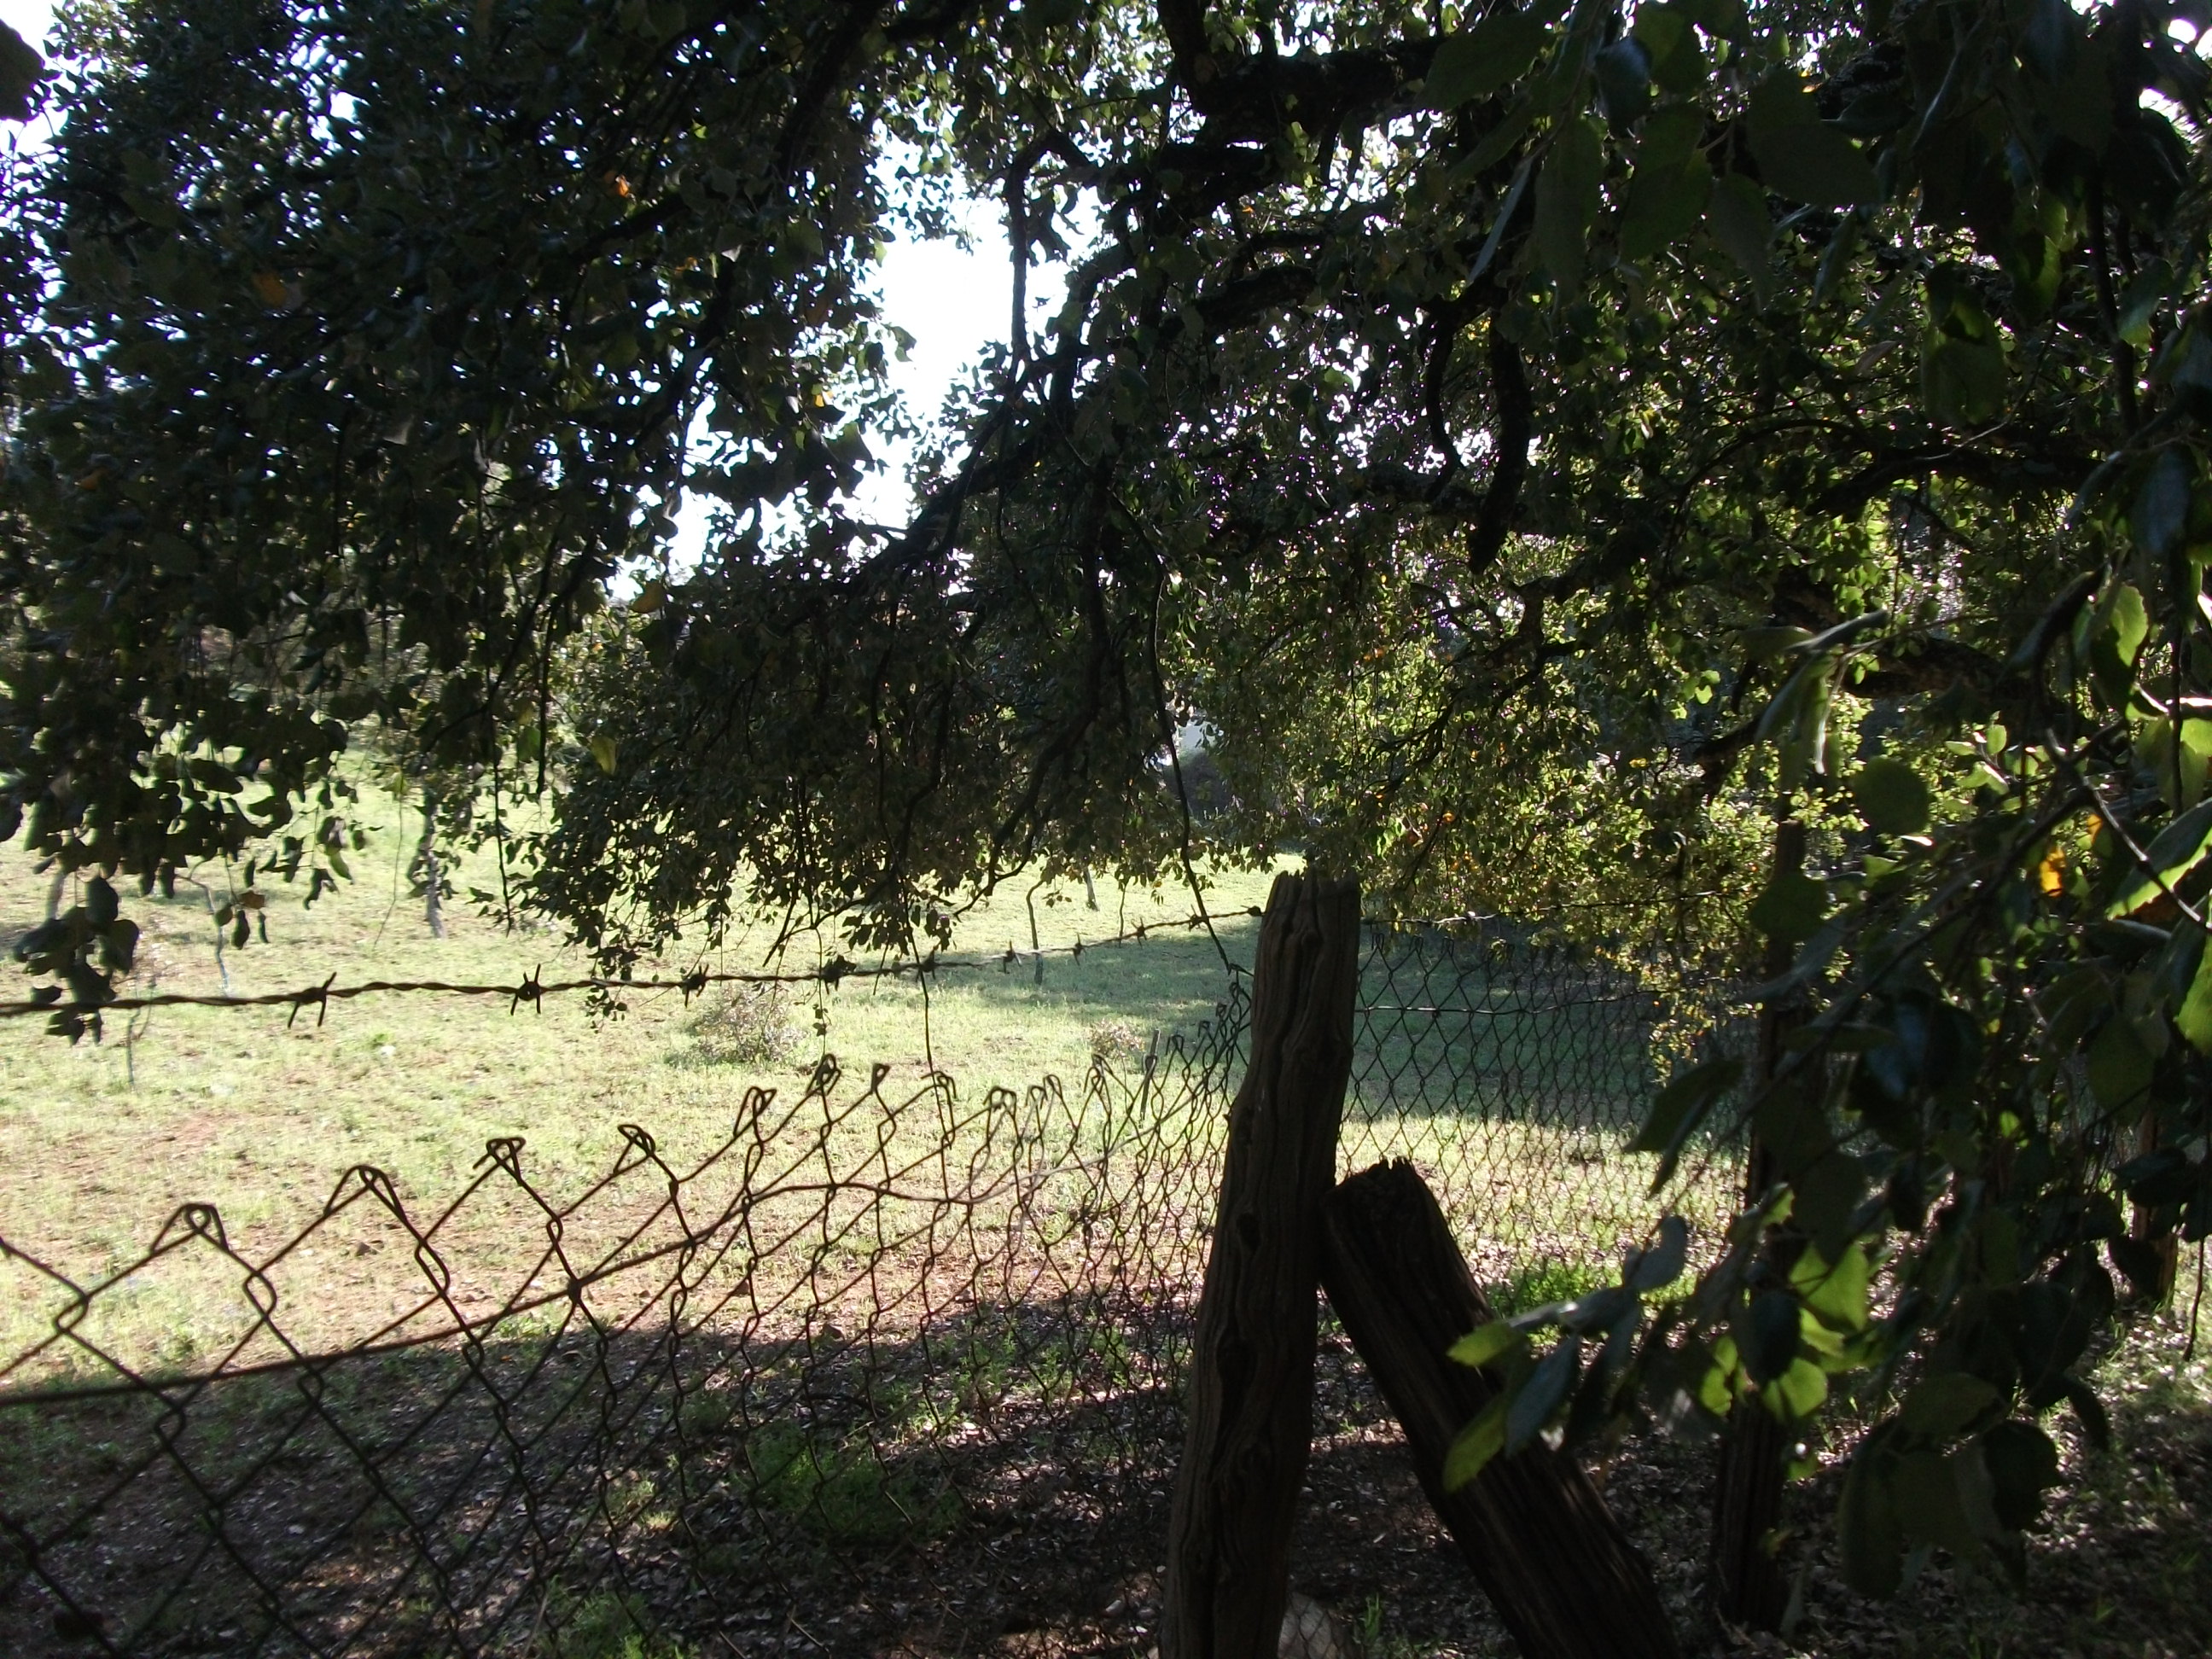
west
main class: Woodland
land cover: Broadleaved woodland
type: broadleaved evergreen forest
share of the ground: 50 - 75 %
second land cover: Grassland without tree/shrub cover
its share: > 75 %
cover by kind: broadleaved forest trees 60 %, herbaceous plants 40 %
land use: Forestry
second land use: Agriculture (excluding fallow land and kitchen gardens)
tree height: > 5 m
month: April
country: ES
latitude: 37.8698
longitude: -6.6763
